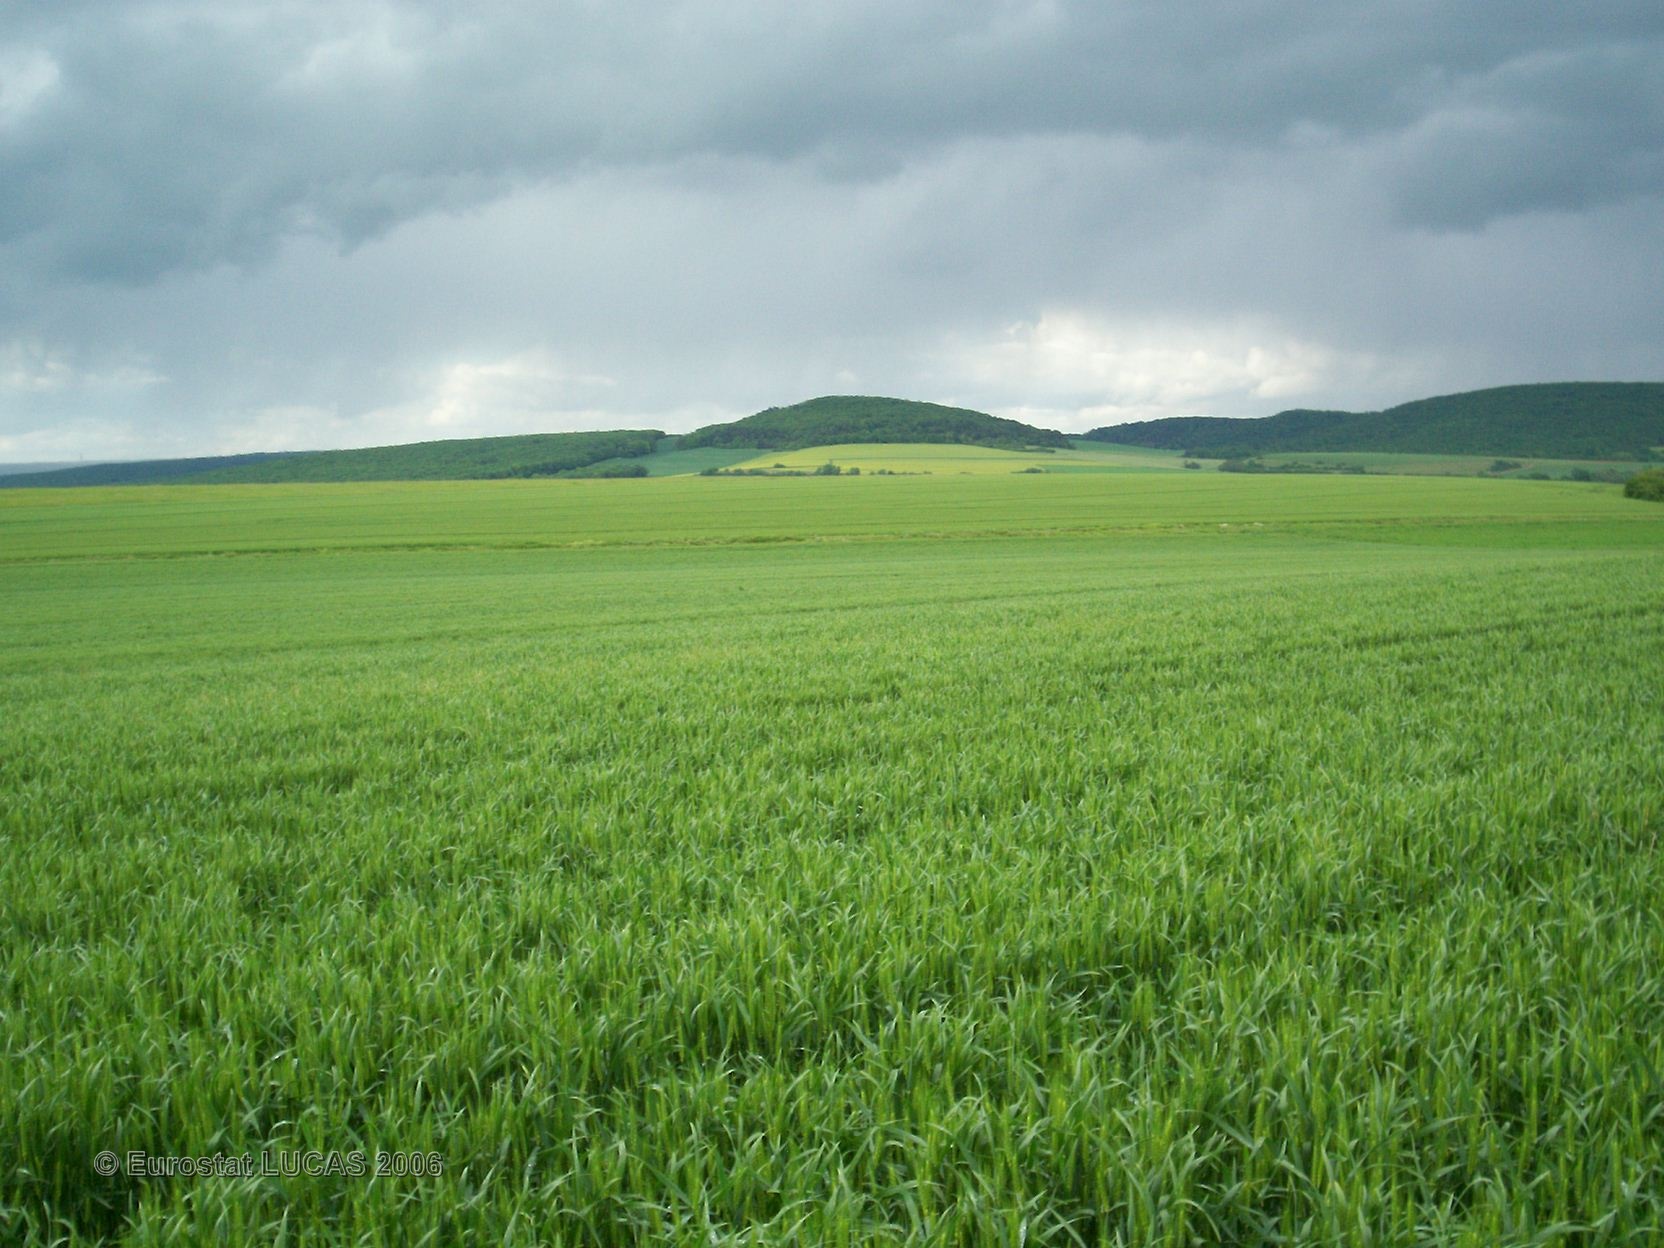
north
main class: Cropland
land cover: Barley
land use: Agriculture (excluding fallow land and kitchen gardens)
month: May
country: FR
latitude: 47.4981
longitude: 5.0221
